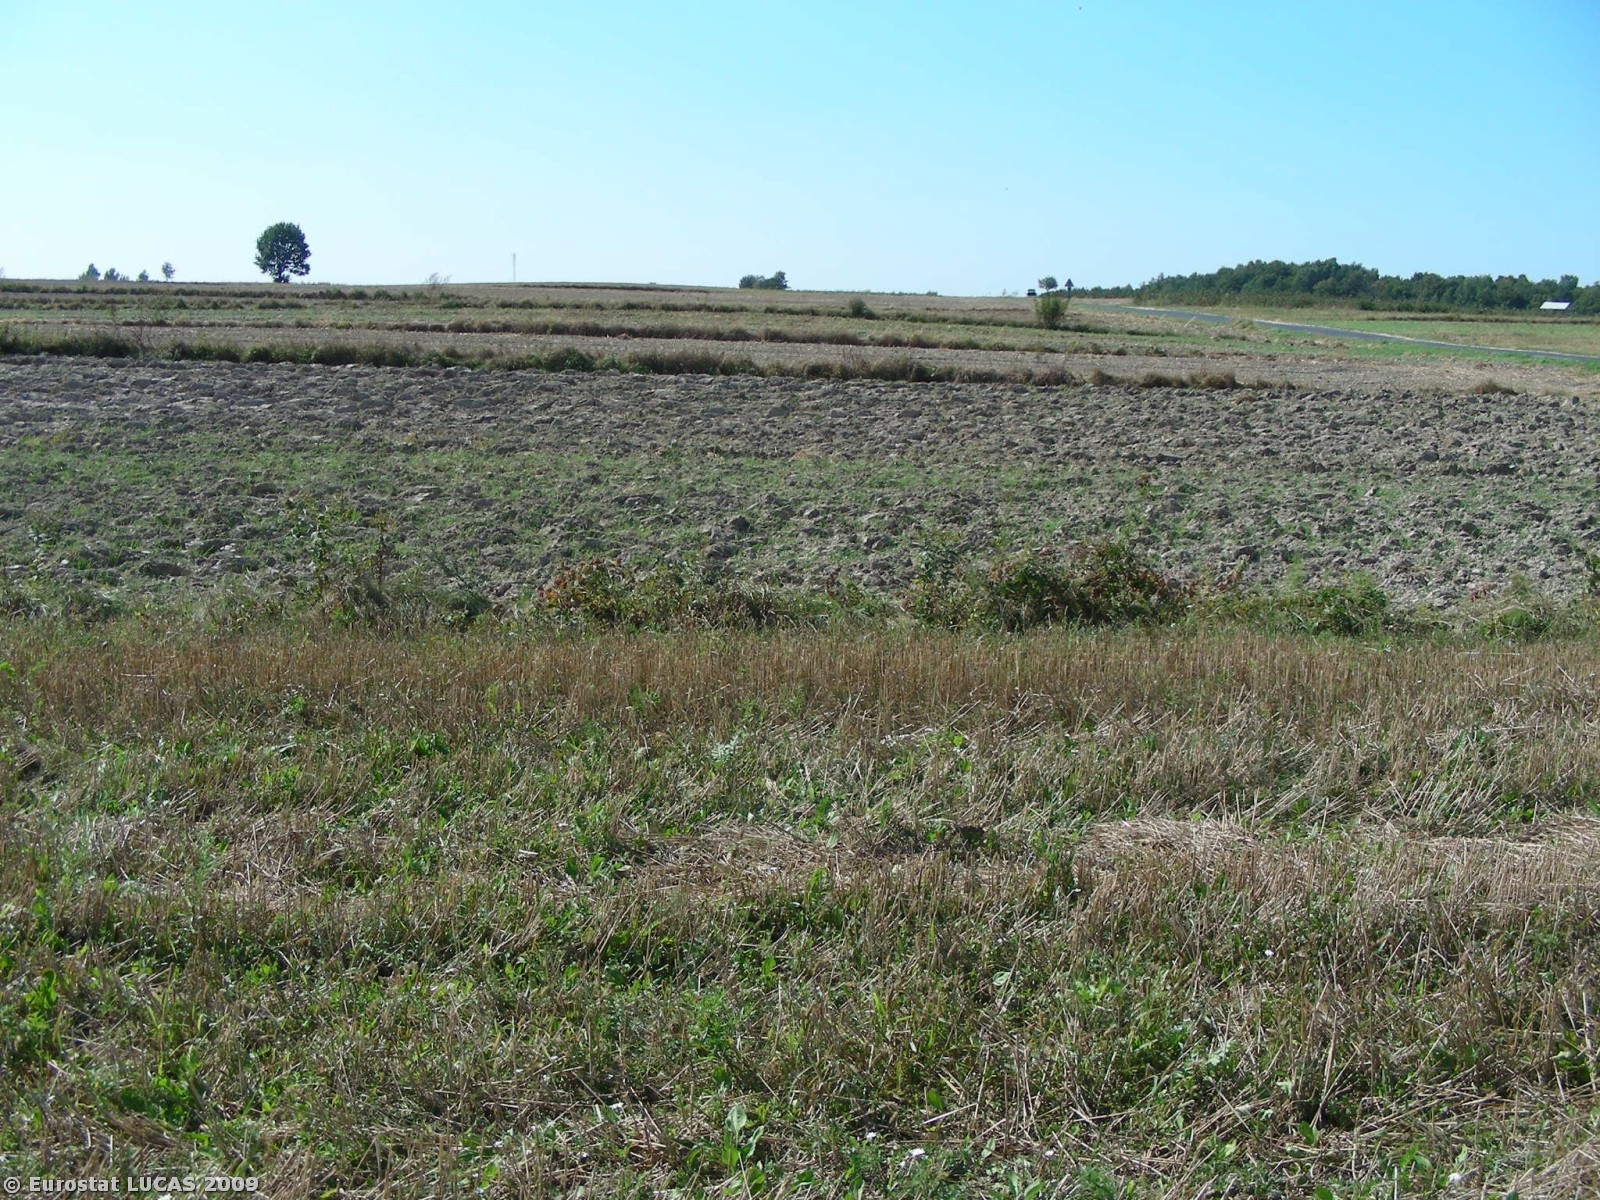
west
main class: Cropland
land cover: Common wheat
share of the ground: < 10 %
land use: Agriculture (excluding fallow land and kitchen gardens)
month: September
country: PL
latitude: 50.8944
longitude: 22.3331
